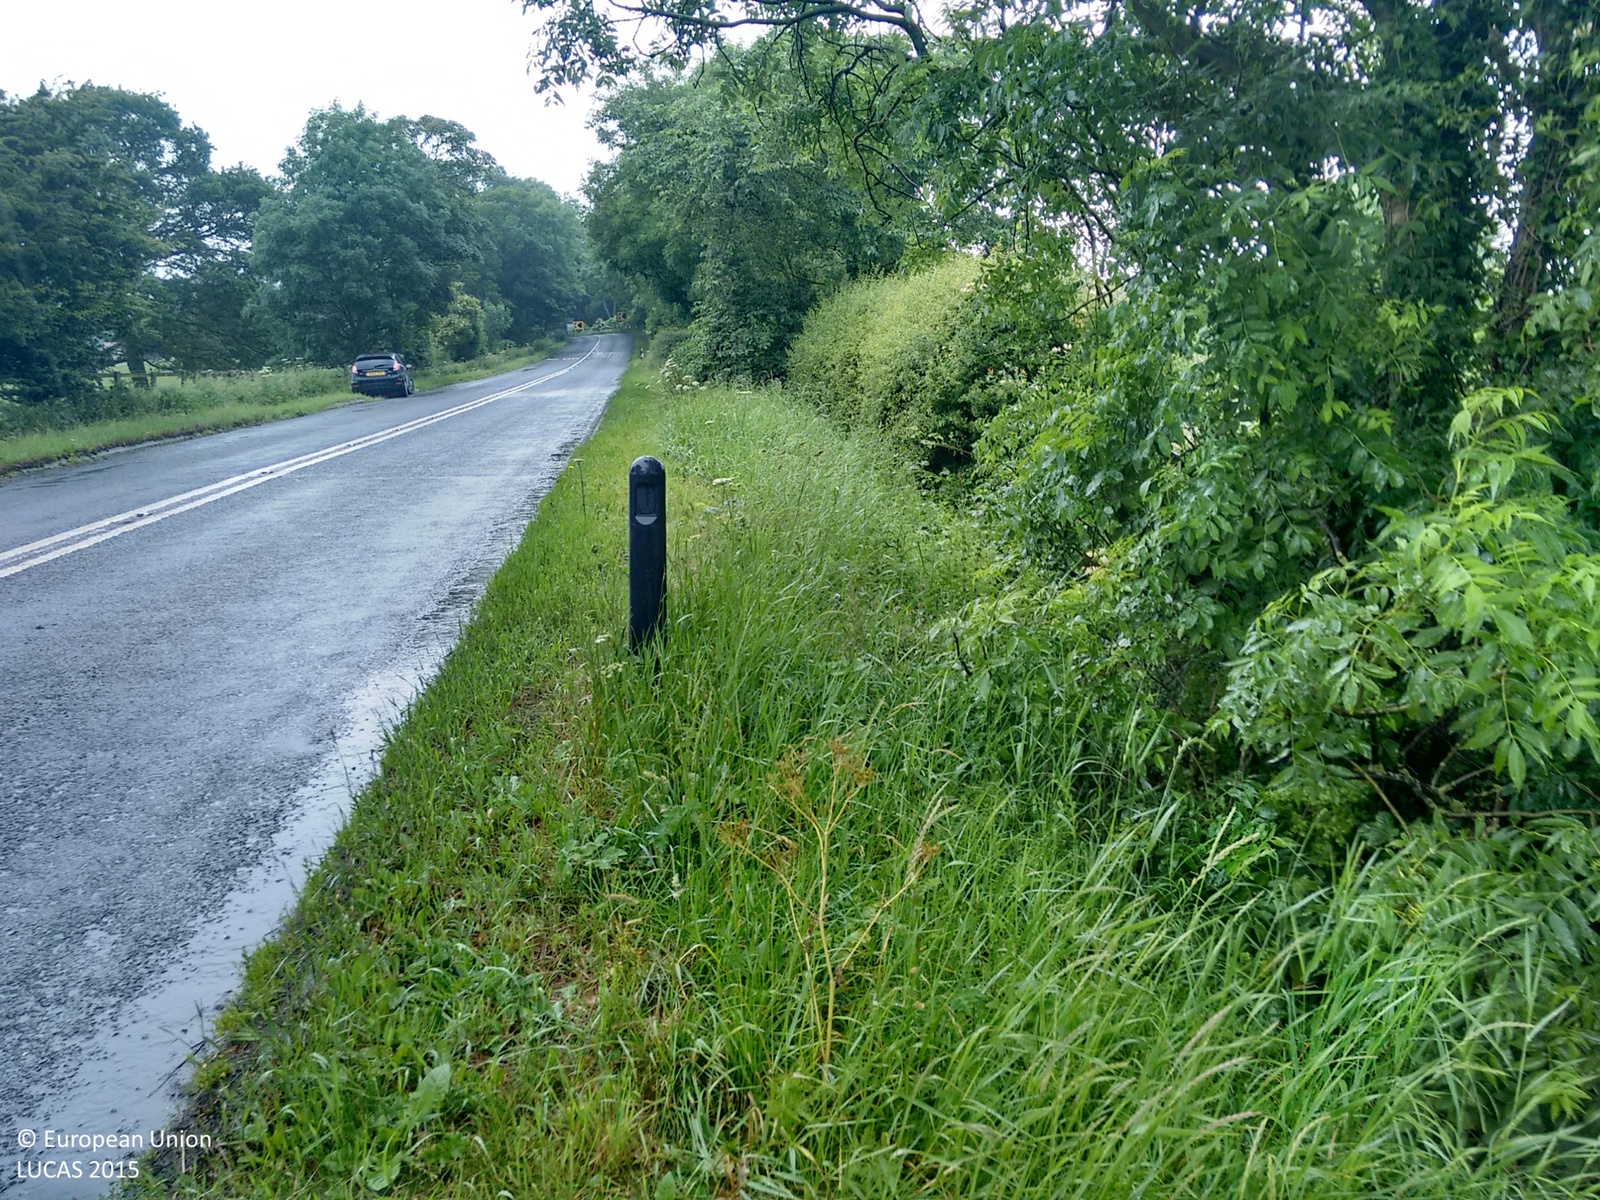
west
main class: Woodland
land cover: Broadleaved woodland
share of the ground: > 75 %
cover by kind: broadleaved forest trees 45 %, herbaceous plants 15 %
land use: Semi-natural and natural areas not in use
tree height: > 5 m
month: July
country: GB
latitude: 54.5452
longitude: -1.8482
